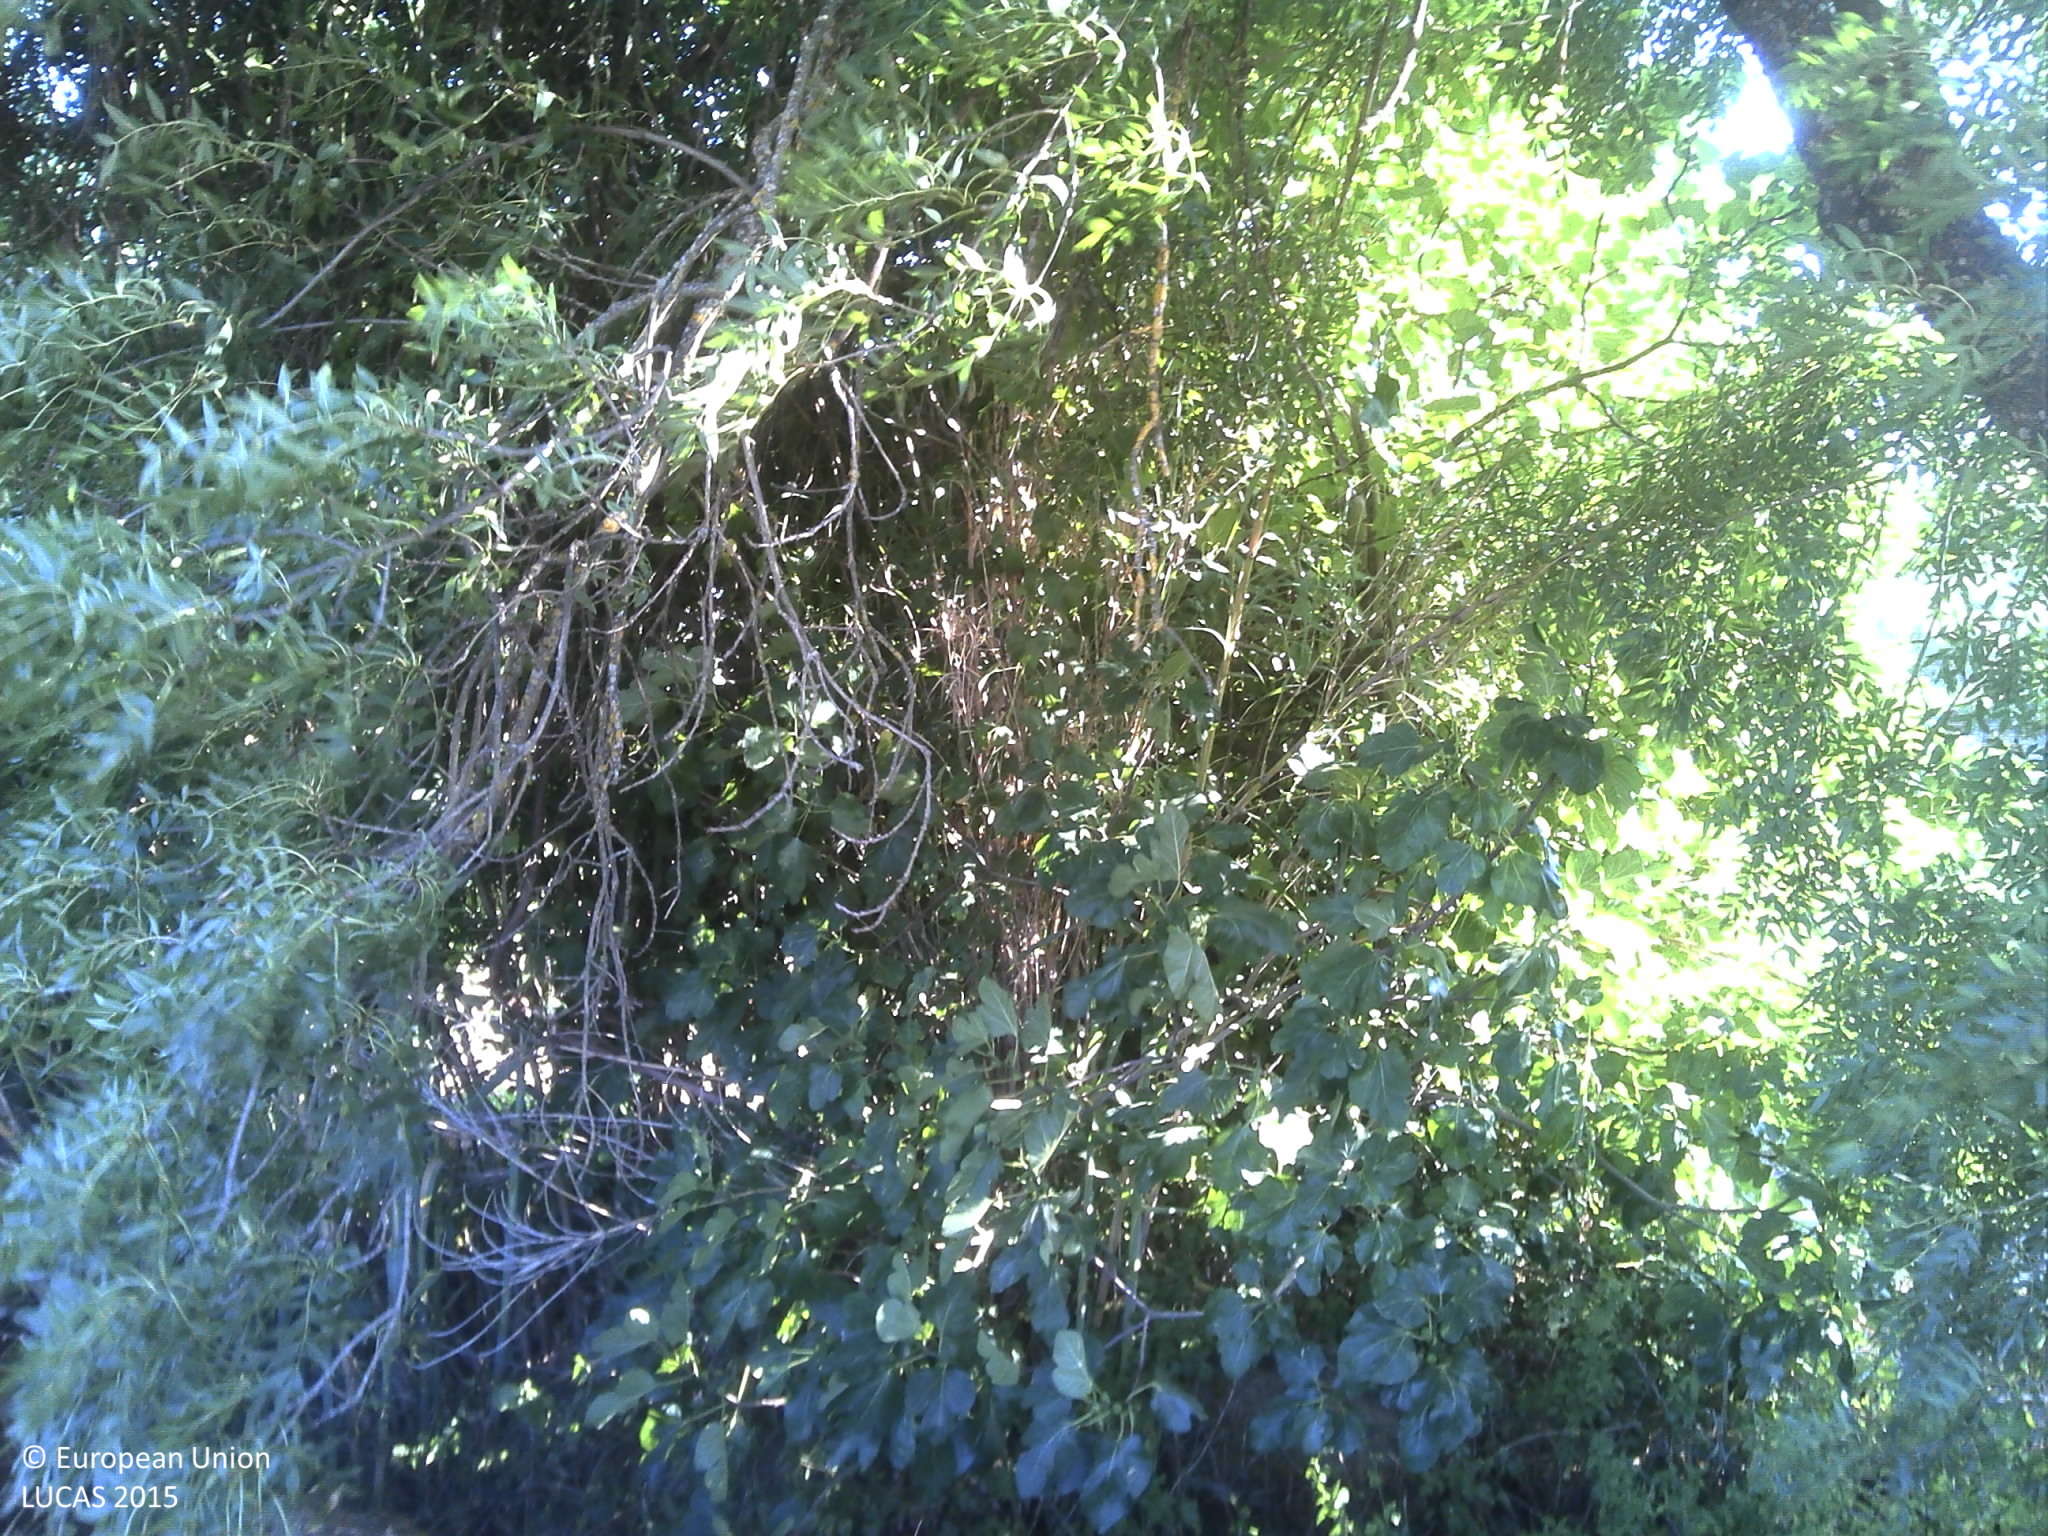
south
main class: Cropland
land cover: Vineyards
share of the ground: 10 - 25 %
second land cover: Other bare soil
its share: > 75 %
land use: Agriculture (excluding fallow land and kitchen gardens)
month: July
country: PT
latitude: 40.3198
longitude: -7.4171
